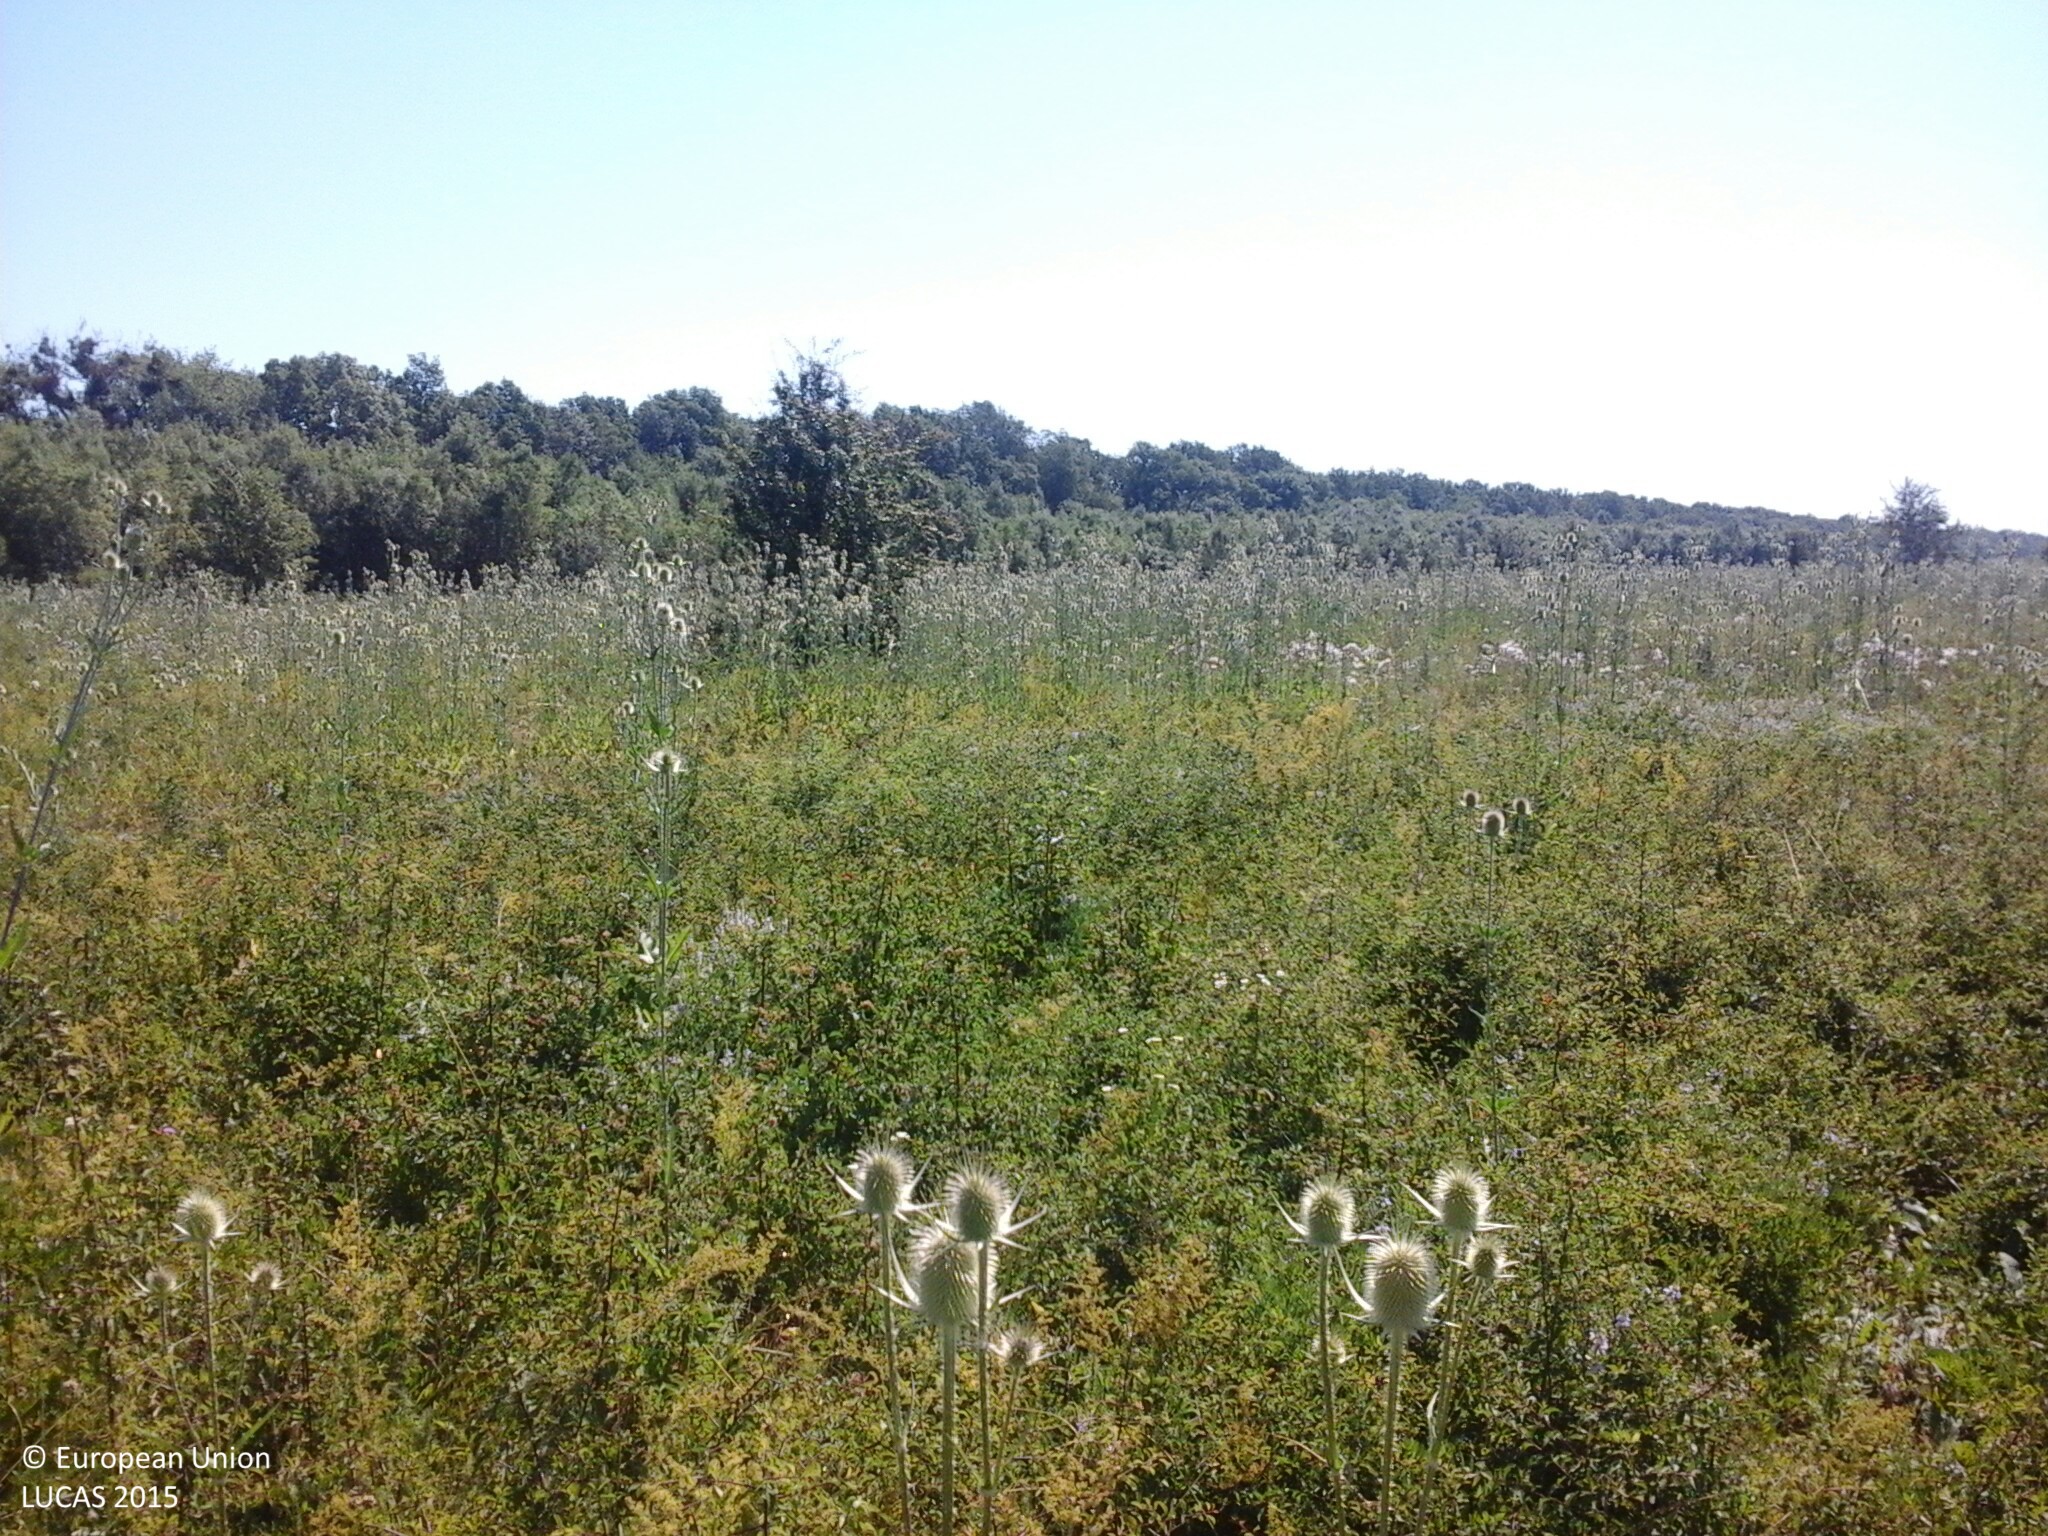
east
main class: Grassland
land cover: Spontaneously vegetated surfaces
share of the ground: > 75 %
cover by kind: herbaceous plants 100 %
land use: Semi-natural and natural areas not in use
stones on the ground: < 10 %
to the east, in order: Spontaneously vegetated surfaces; Broadleaved woodland; Grassland without tree/shrub cover; Tracks
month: July
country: HU
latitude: 48.1205
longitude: 22.4043
